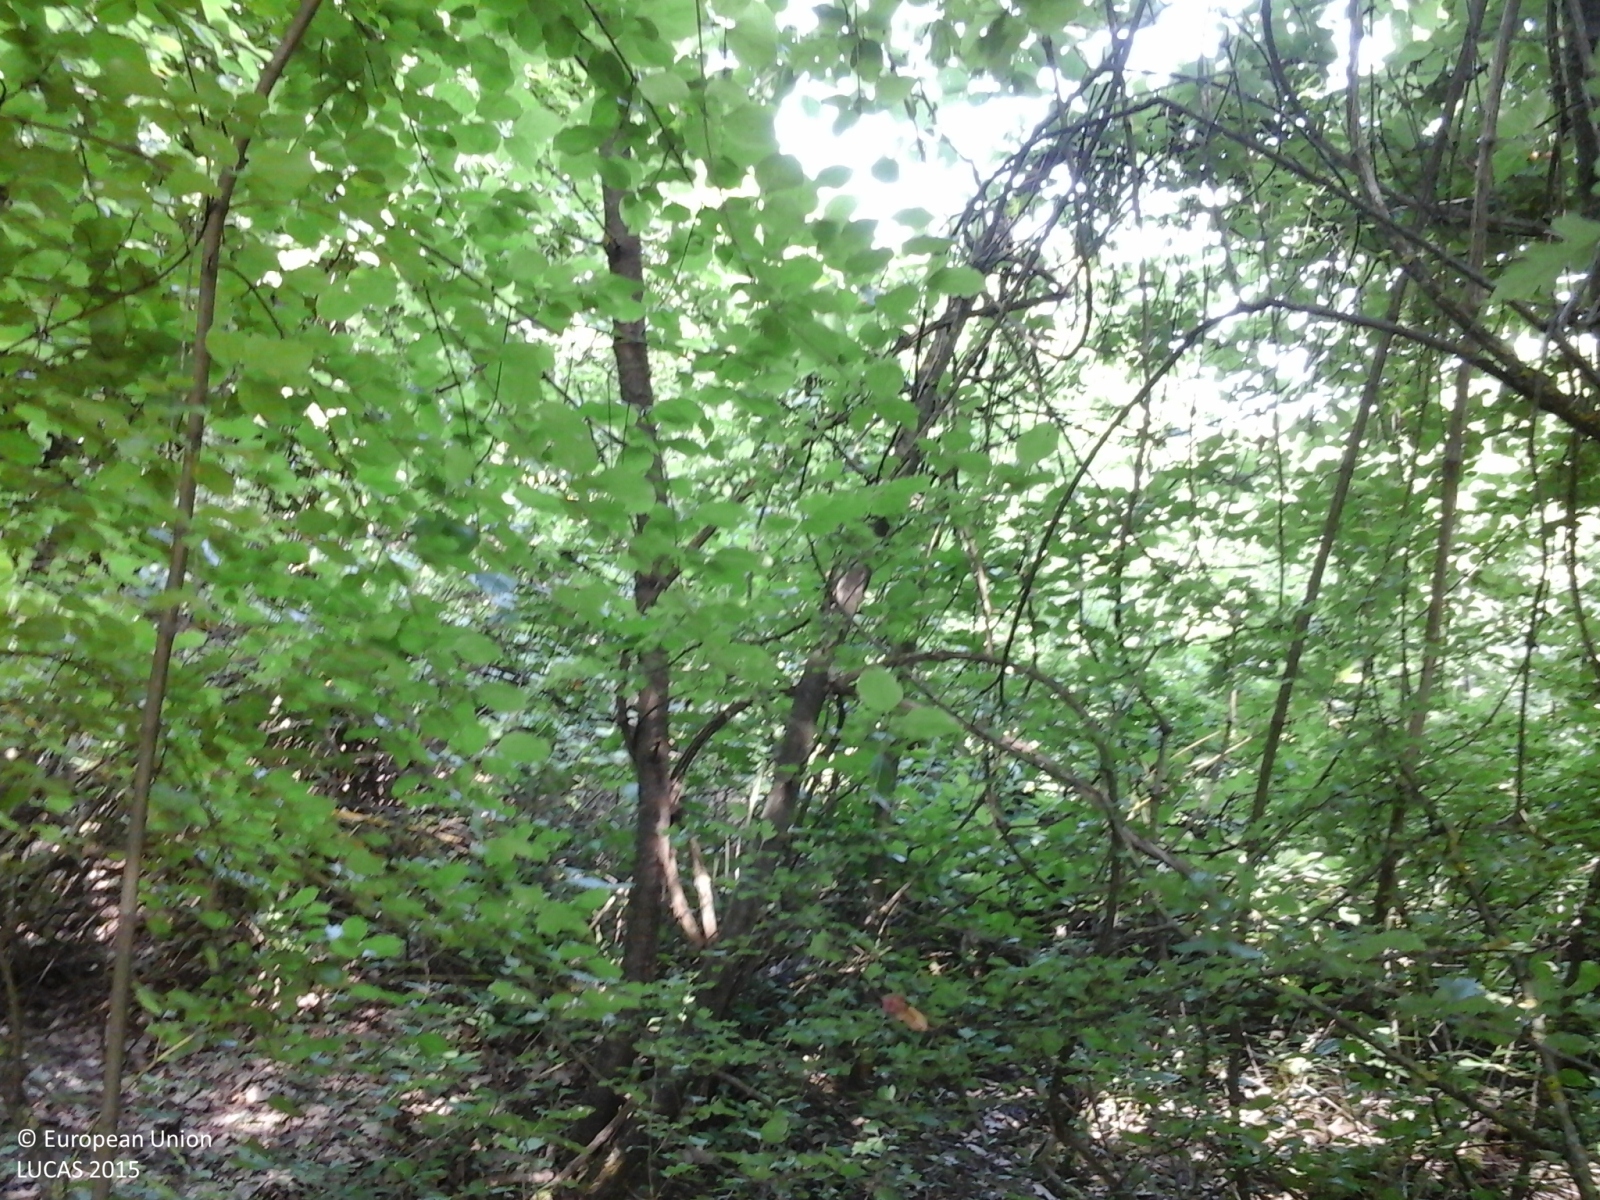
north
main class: Woodland
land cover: Broadleaved woodland
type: thermophilous deciduous forest
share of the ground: > 75 %
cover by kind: broadleaved forest trees 95 %, shrubs 5 %
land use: Forestry
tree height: > 5 m
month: May
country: IT
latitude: 44.7343
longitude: 8.3491
